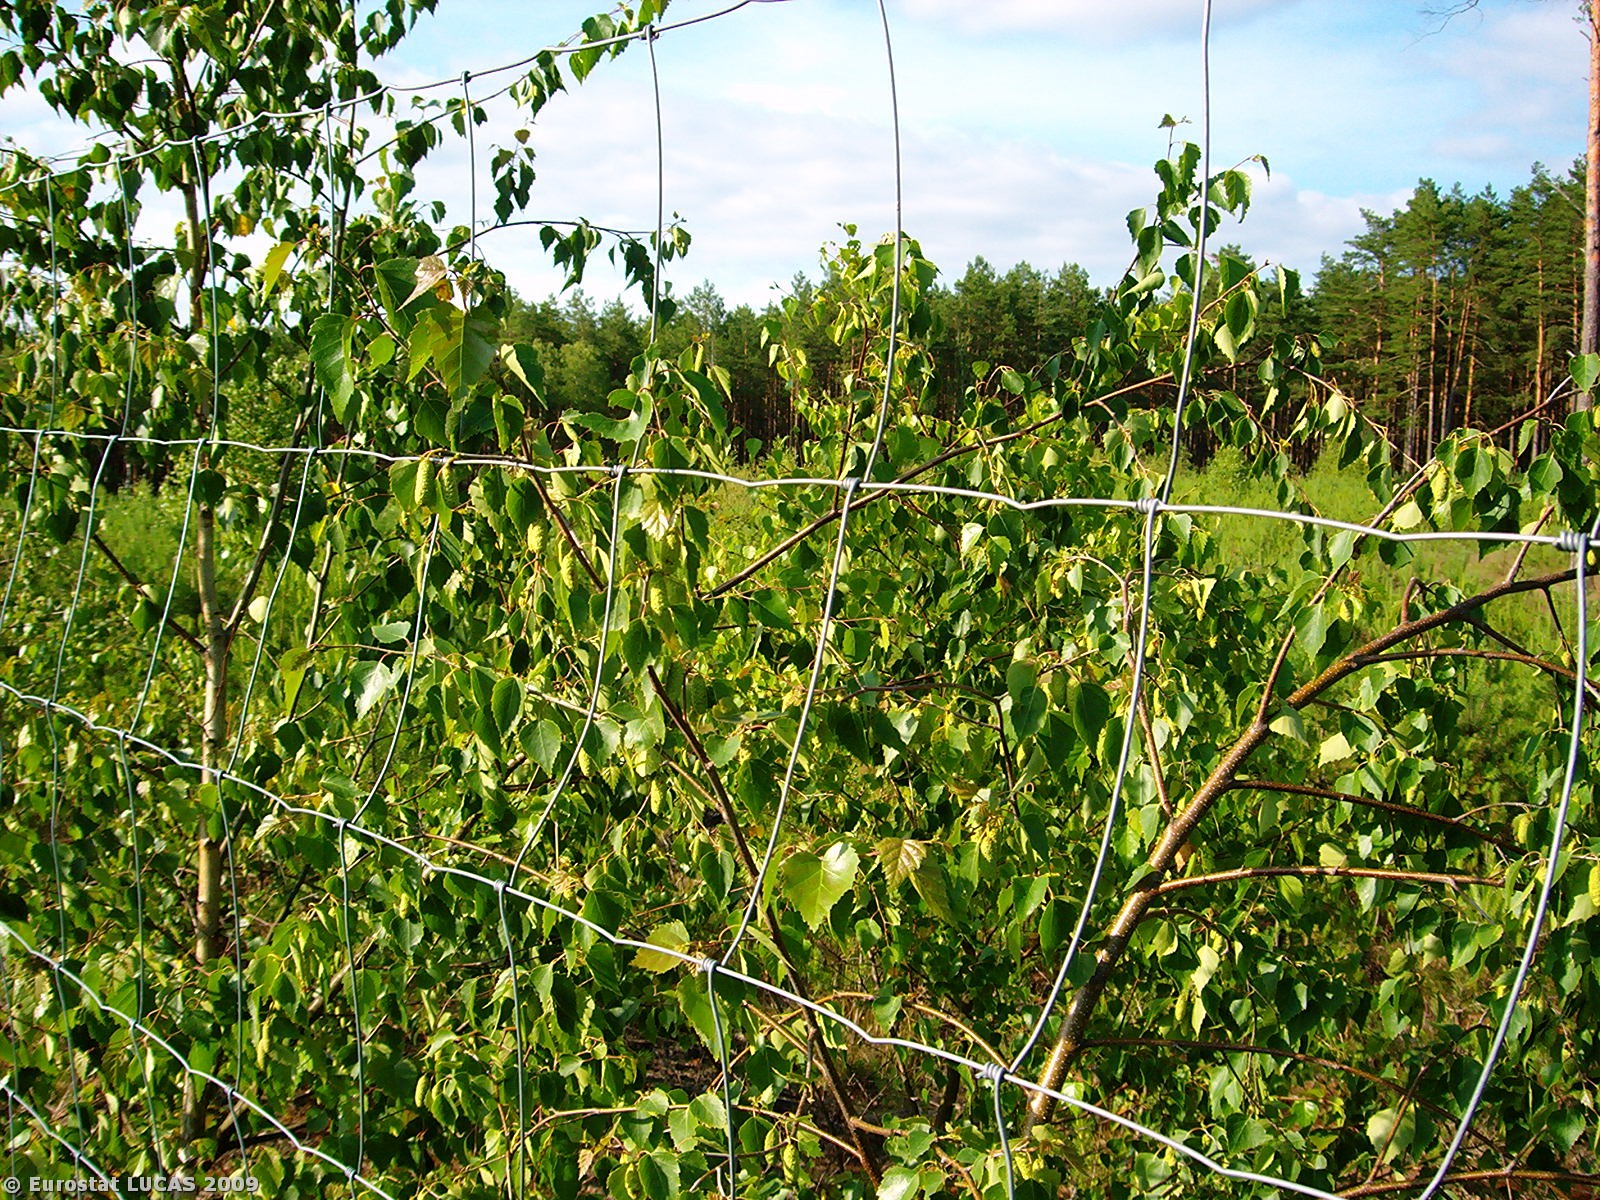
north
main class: Woodland
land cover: Mixed woodland
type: hemiboreal forest and nemoral coniferous forest and mixed broadleaved-coniferous forest
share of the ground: 25 - 50 %
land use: Forestry
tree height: > 5 m
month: June
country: PL
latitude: 53.2017
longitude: 15.9482
